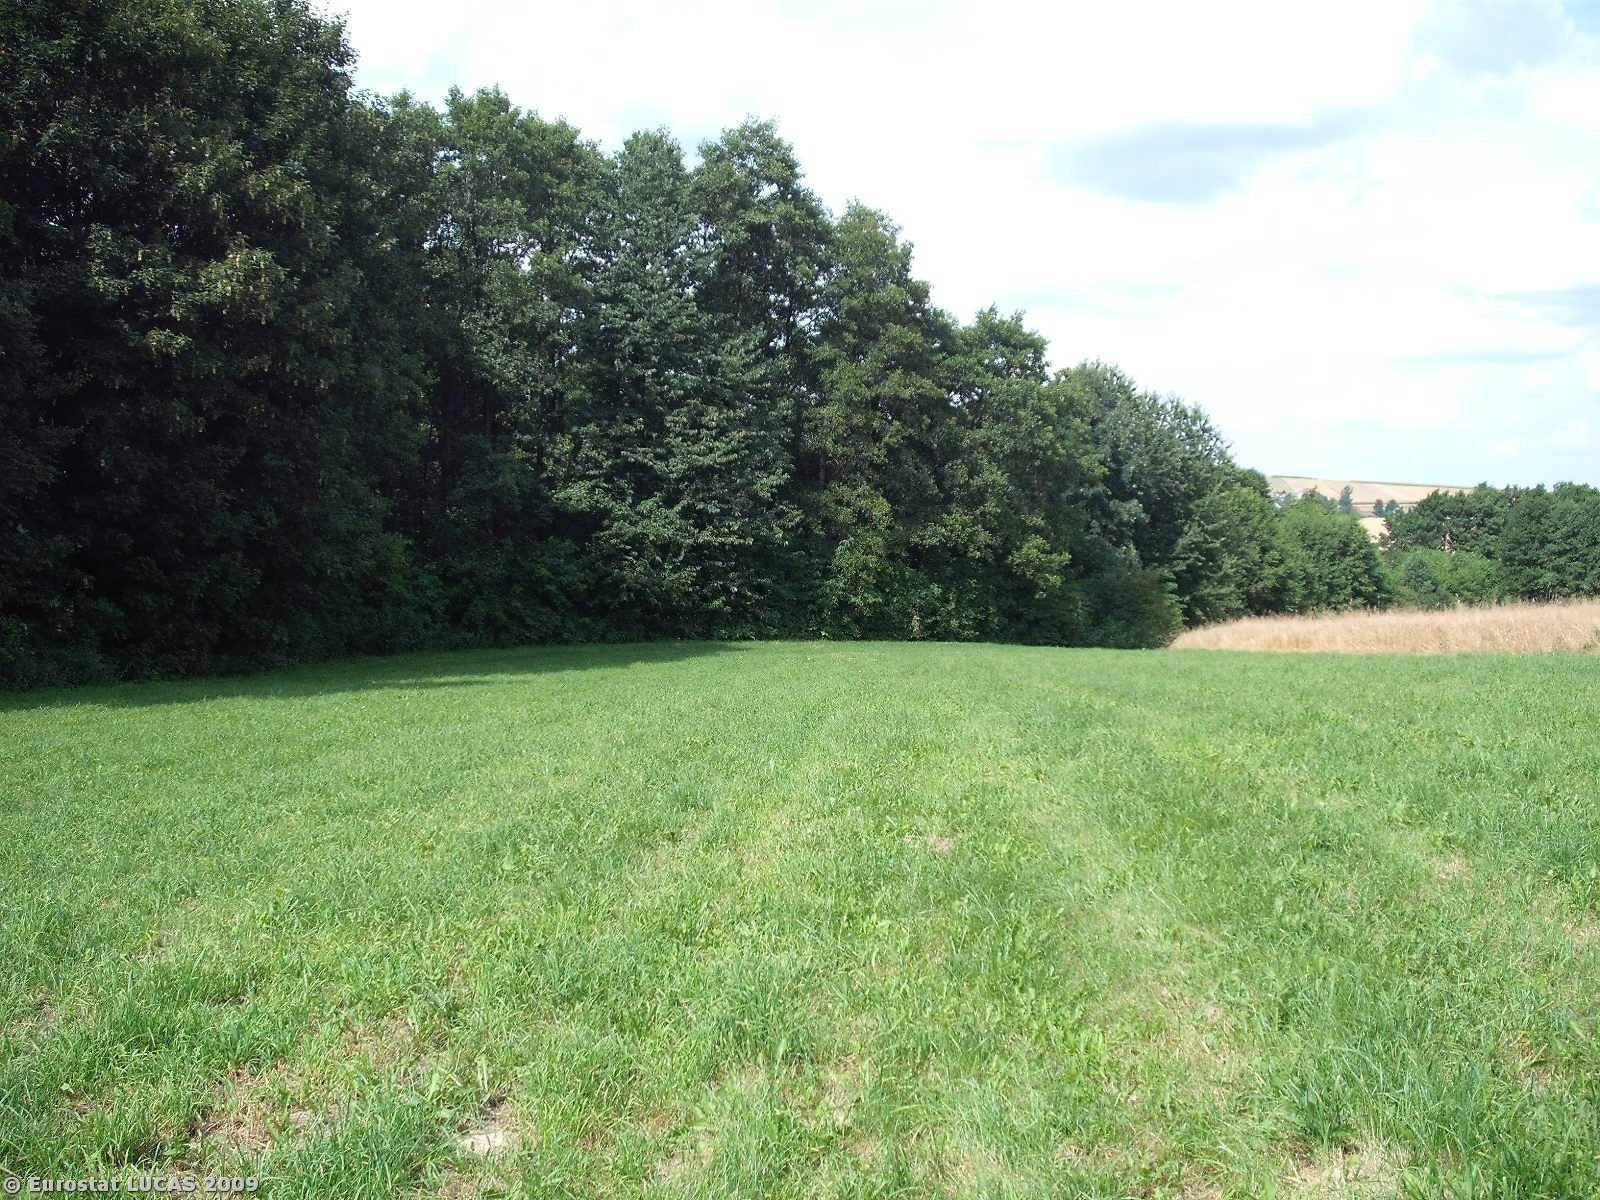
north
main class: Grassland
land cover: Grassland without tree/shrub cover
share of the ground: > 75 %
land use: Agriculture (excluding fallow land and kitchen gardens)
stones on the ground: < 10 %
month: July
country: PL
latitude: 50.6535
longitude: 21.3214
